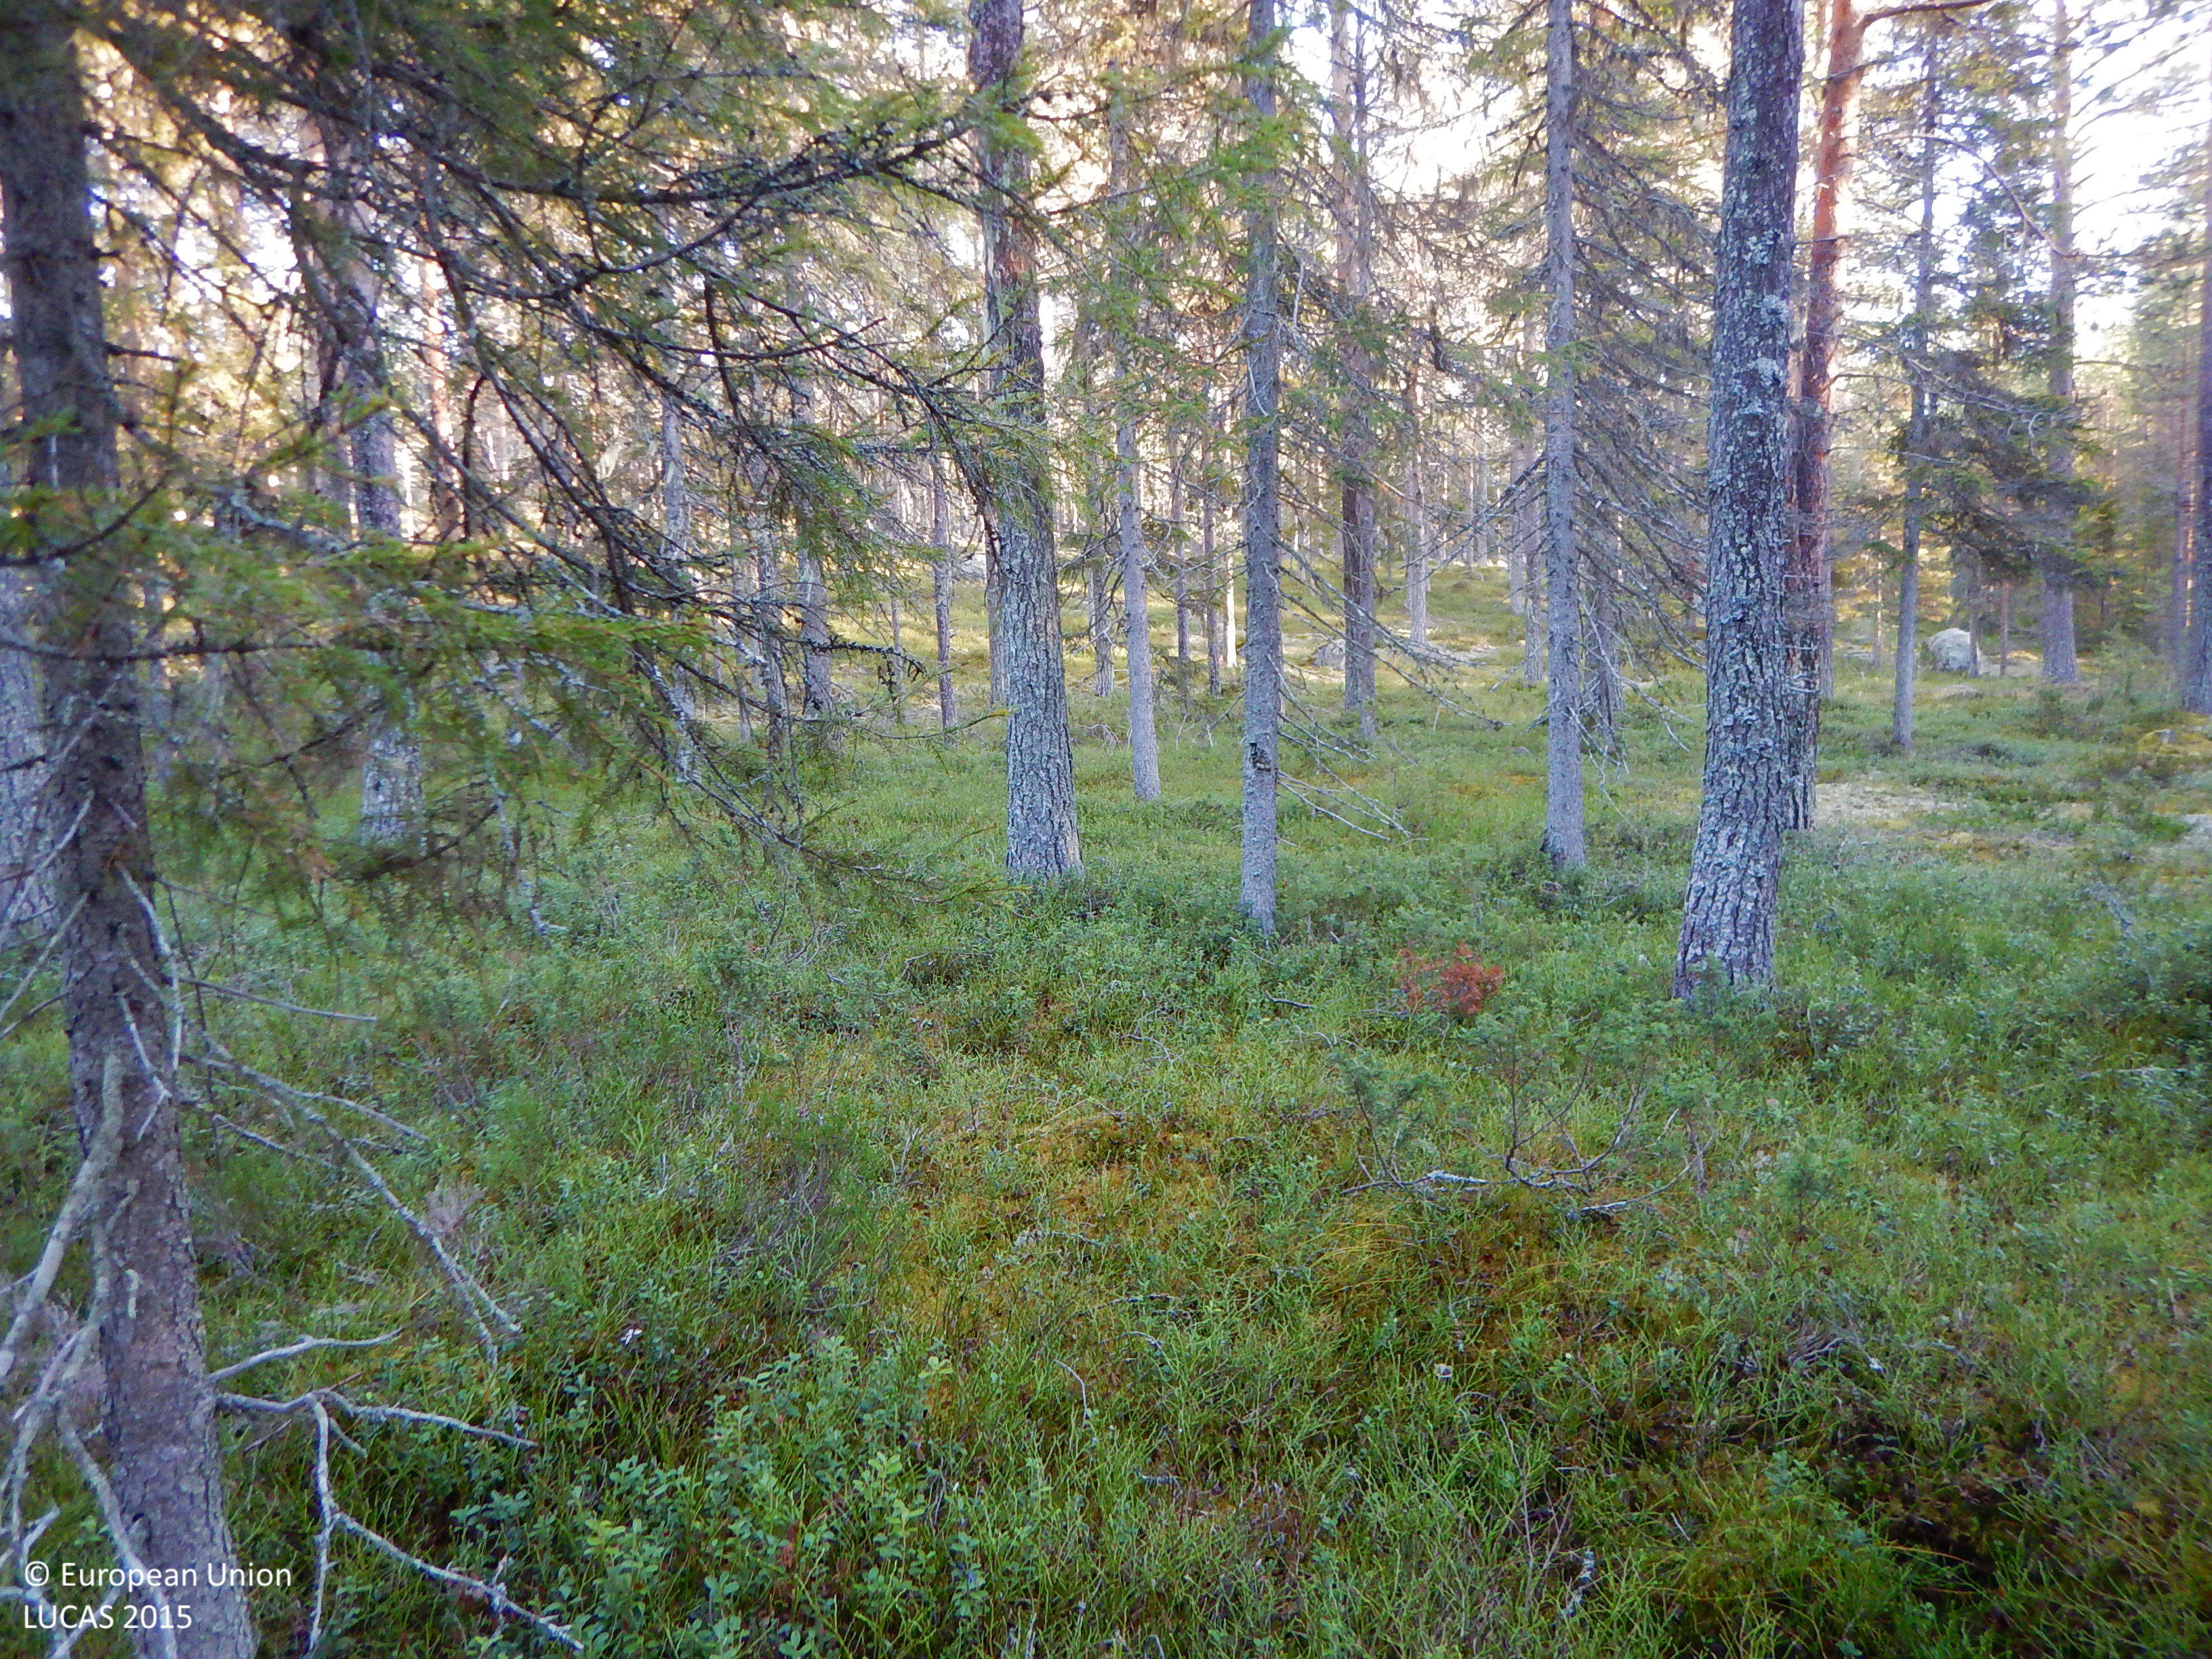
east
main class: Woodland
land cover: Other coniferous woodland
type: boreal forest
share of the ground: 50 - 75 %
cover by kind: coniferous forest trees 65 %, shrubs 15 %, lichens and mosses 15 %, herbaceous plants 5 %
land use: Forestry
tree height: > 5 m
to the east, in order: Other coniferous woodland; Pine dominated coniferous woodland; Other coniferous woodland; Ditches and canals; Tracks; Ditches and canals; Other coniferous woodland; Other mixed woodland
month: November
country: SE
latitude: 65.2875
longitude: 21.0994
